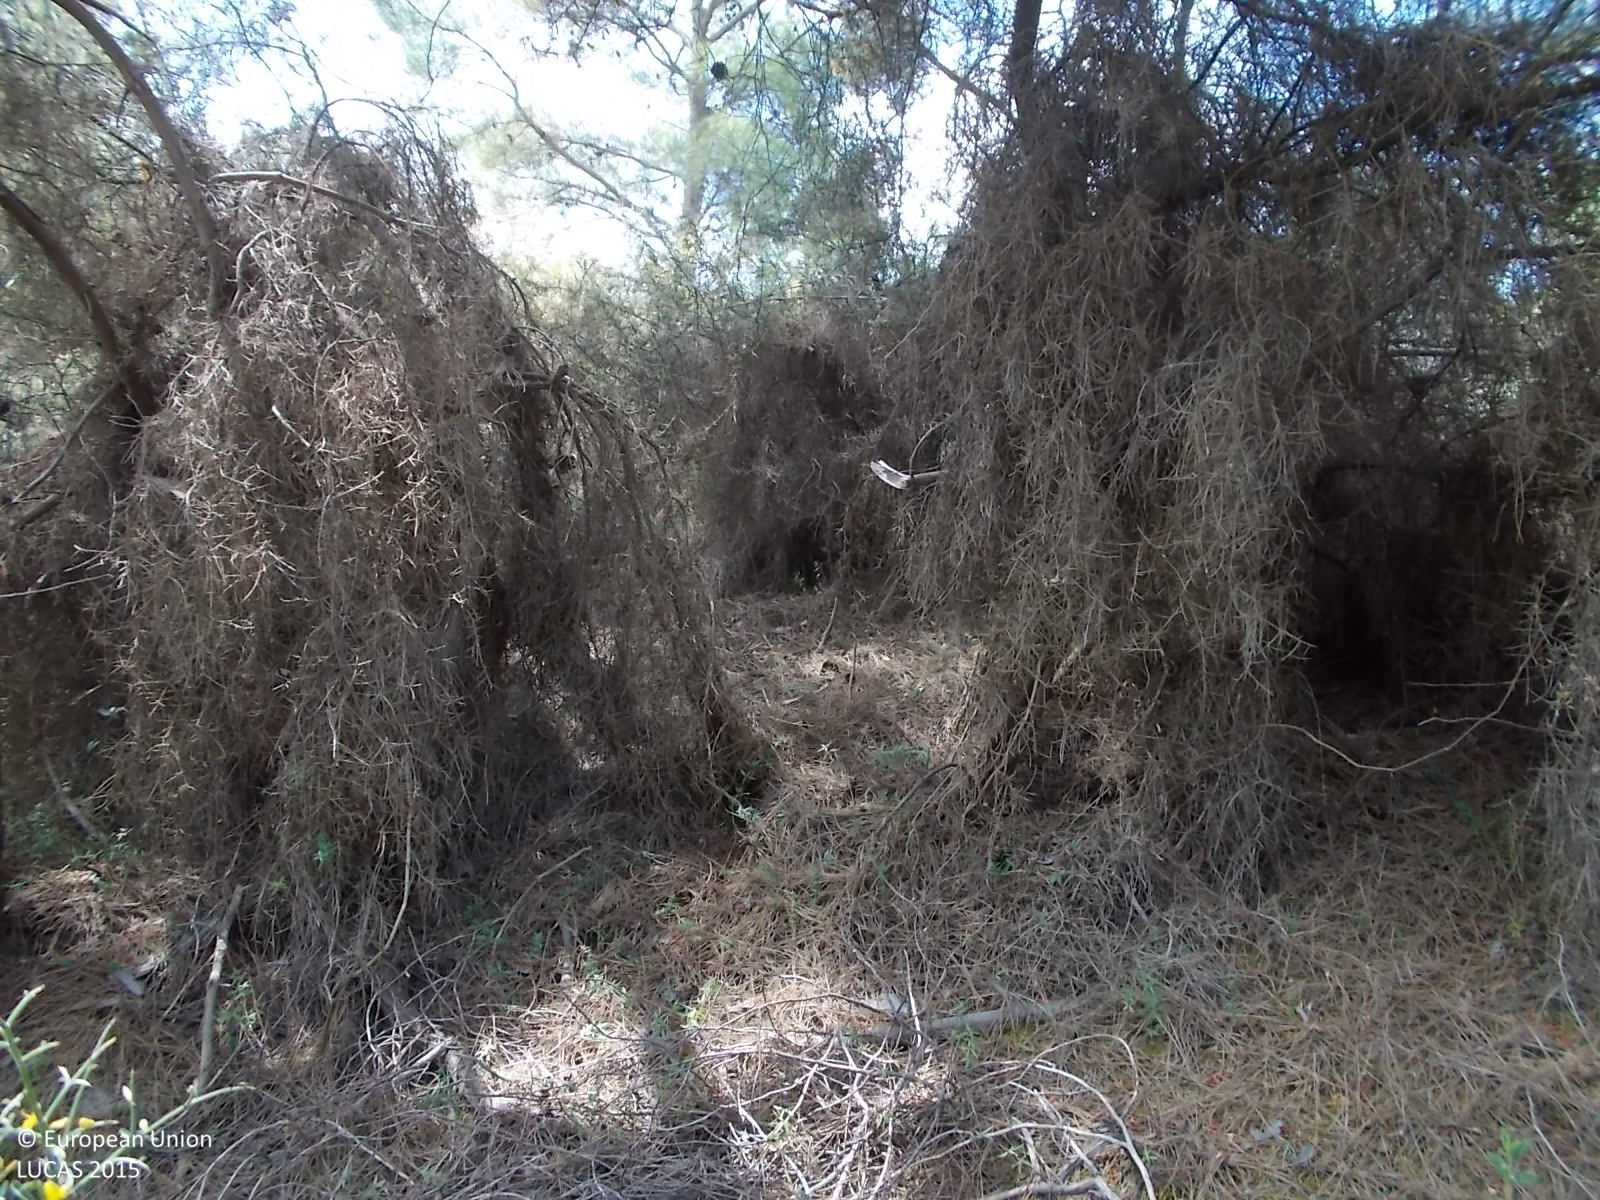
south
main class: Woodland
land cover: Pine dominated coniferous woodland
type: coniferous forest of the mediterranean region
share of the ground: > 75 %
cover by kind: coniferous forest trees 85 %, shrubs 10 %, unconsolidated bare surface 5 %
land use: Forestry
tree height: > 5 m
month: June
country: CY
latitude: 34.8878
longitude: 32.7784
